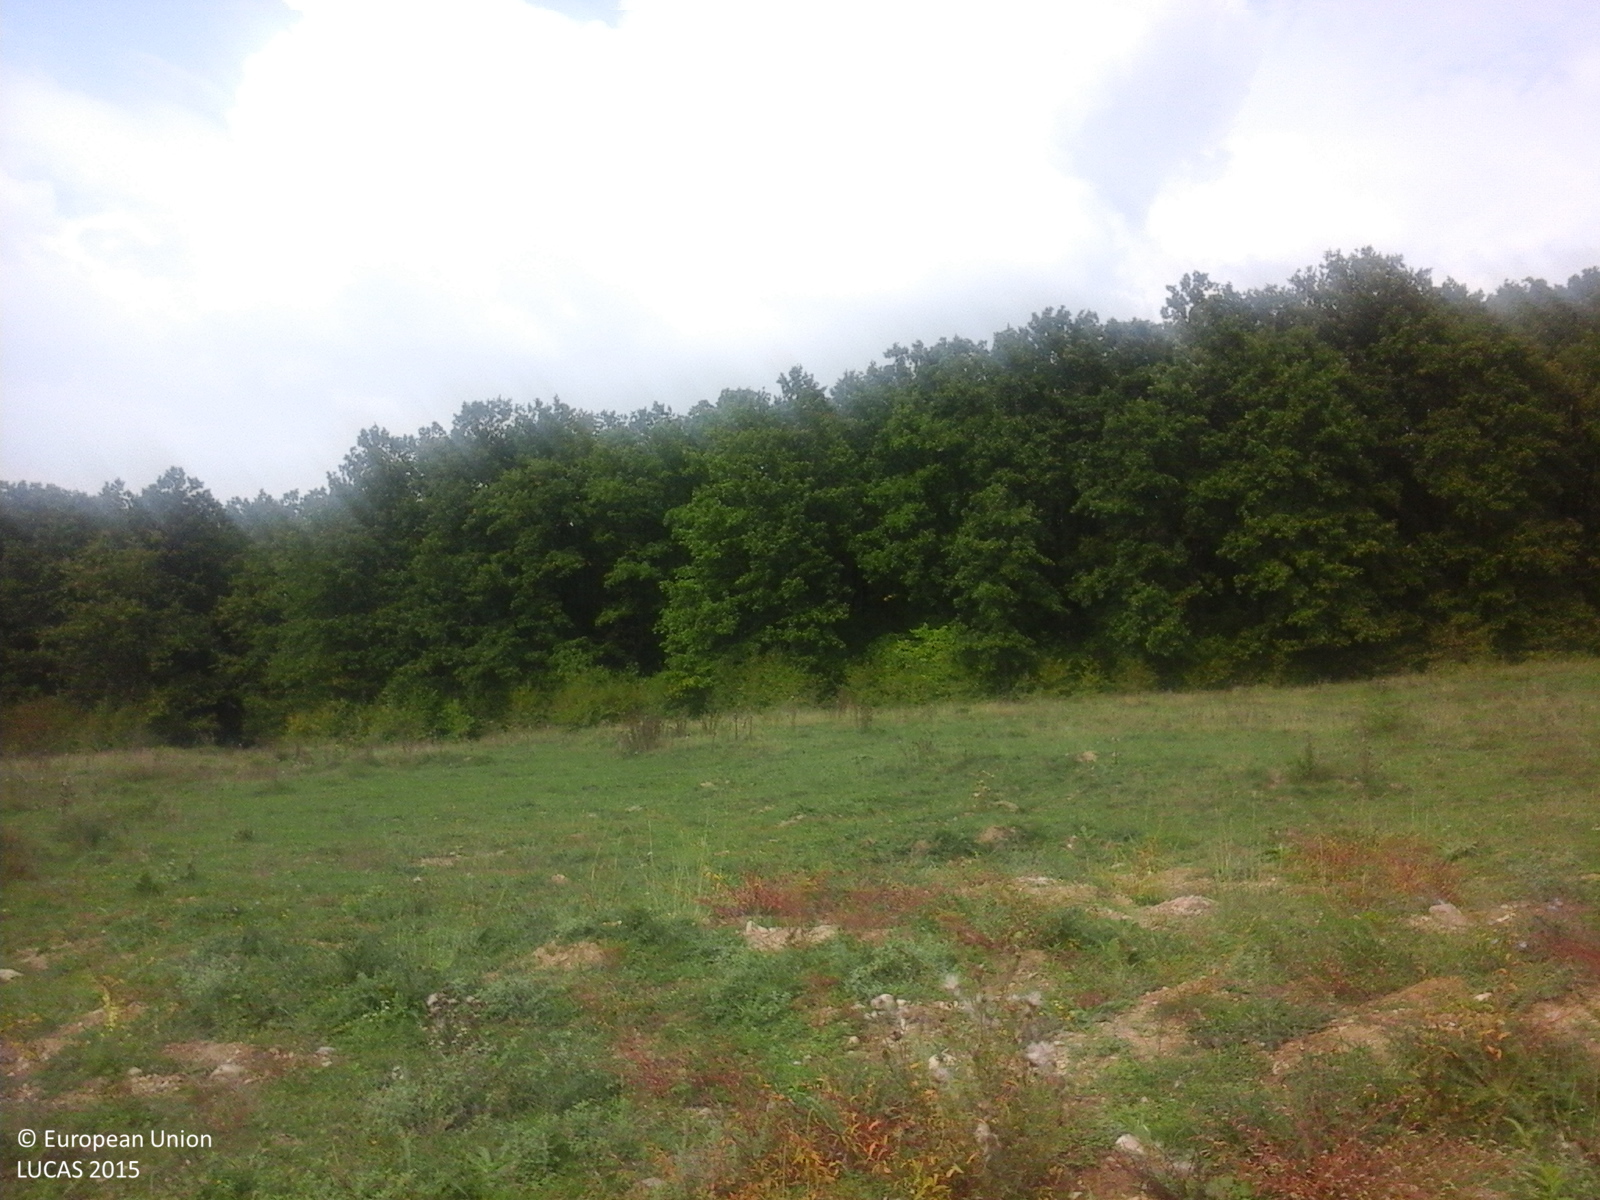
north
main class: Grassland
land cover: Spontaneously vegetated surfaces
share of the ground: > 75 %
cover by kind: herbaceous plants 100 %
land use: Fallow land
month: September
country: RO
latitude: 45.0520
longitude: 23.2203
